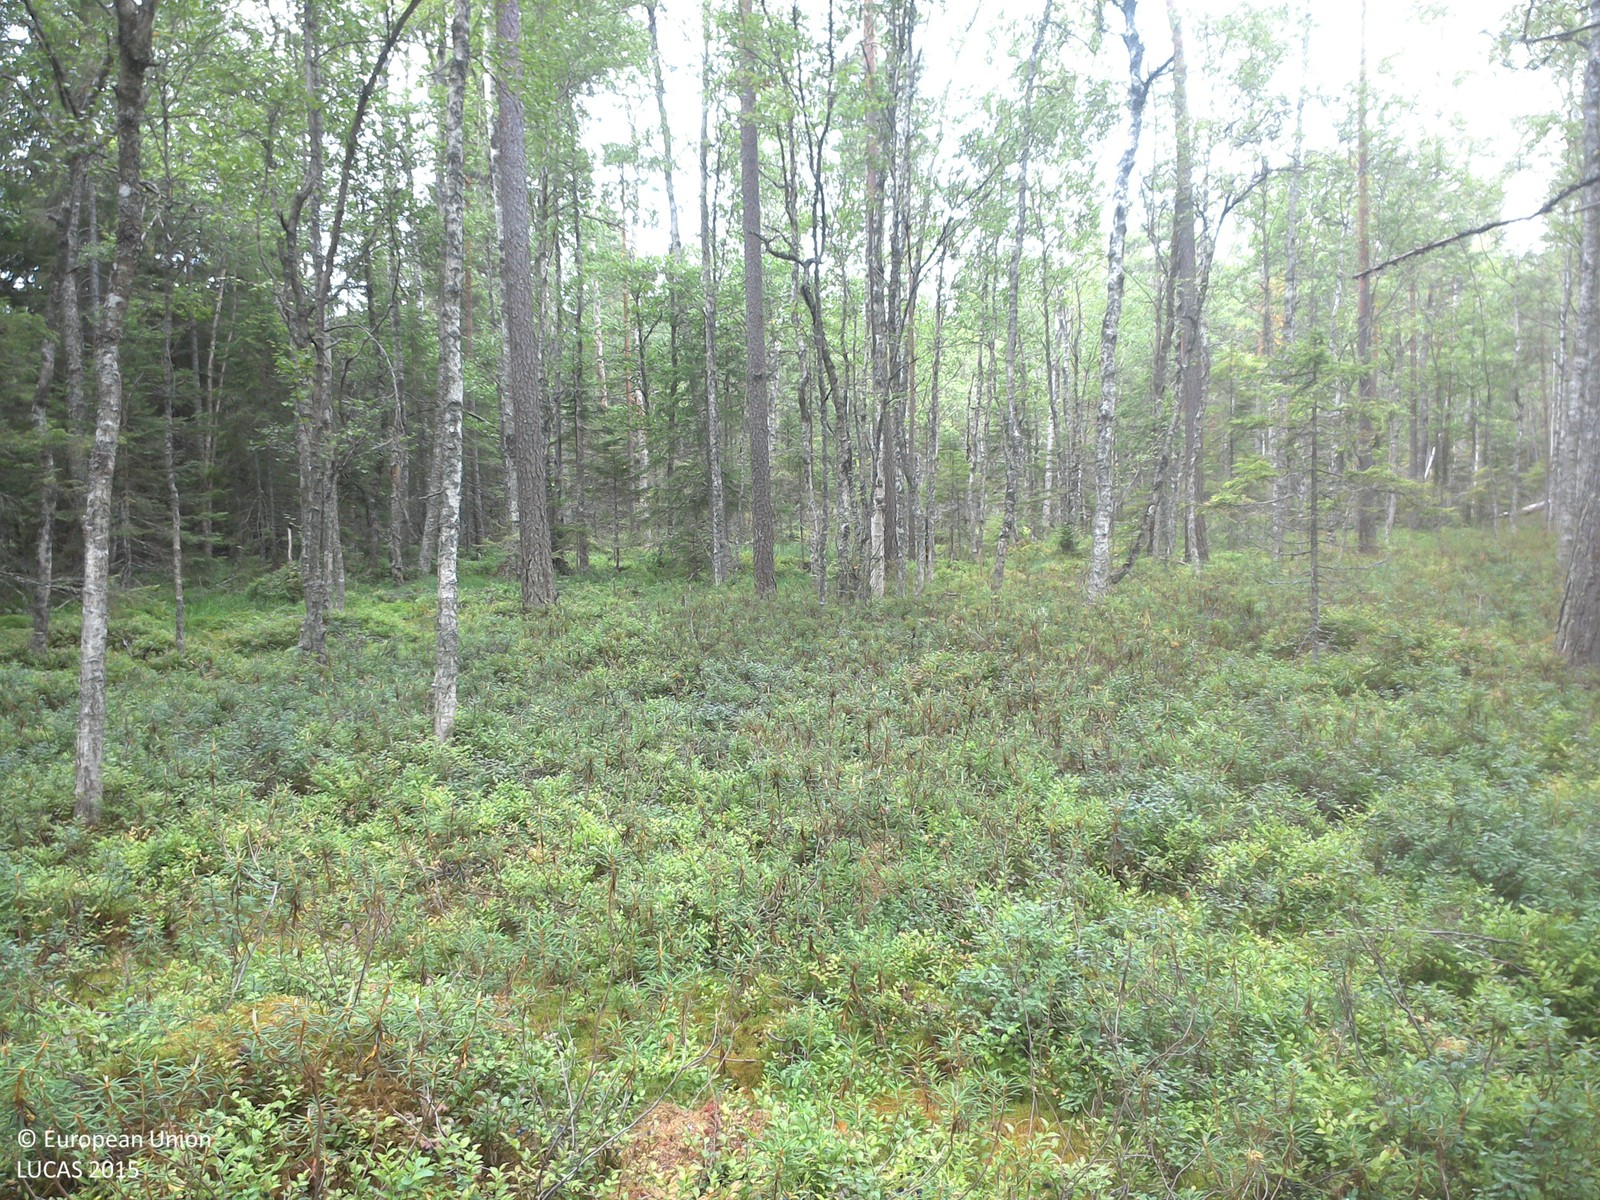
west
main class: Woodland
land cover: Pine dominated mixed woodland
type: boreal forest
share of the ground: 25 - 50 %
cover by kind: herbaceous plants 45 %, coniferous forest trees 30 %, lichens and mosses 15 %, broadleaved forest trees 10 %
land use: Forestry
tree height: > 5 m
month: August
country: SE
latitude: 57.8198
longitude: 15.4672
